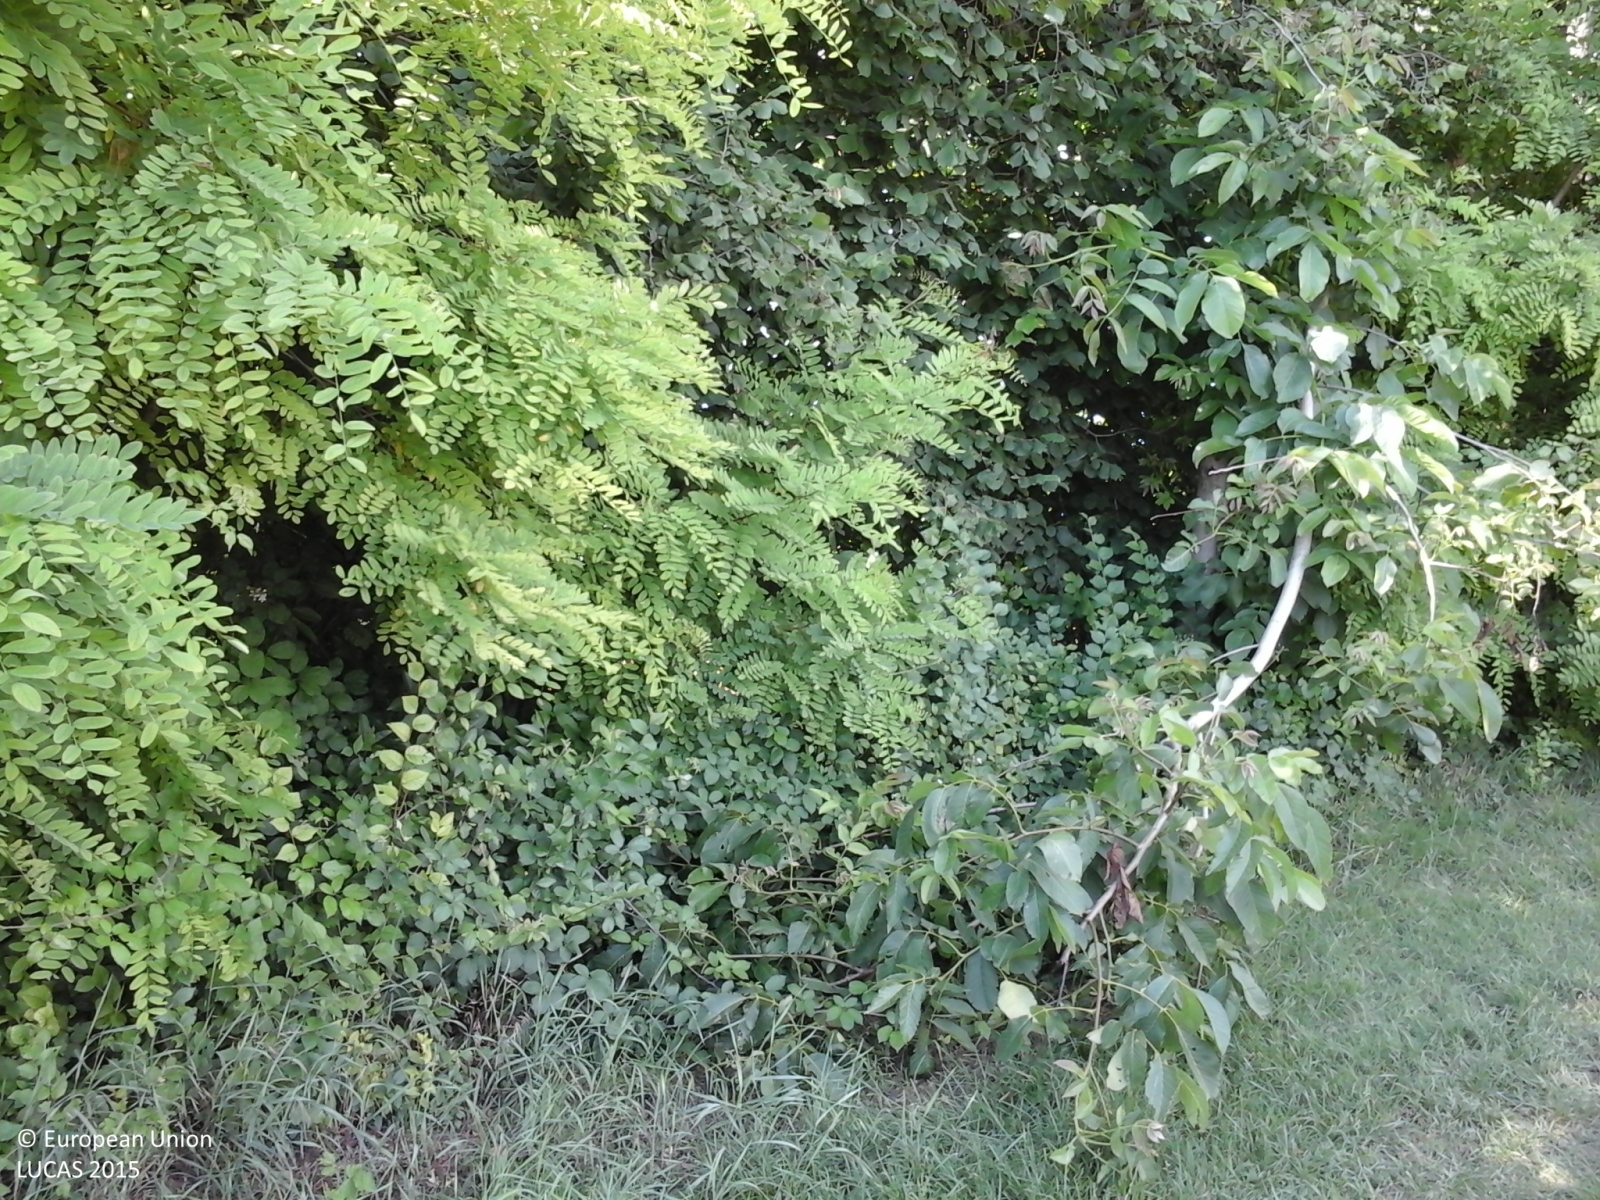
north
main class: Cropland
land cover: Common wheat
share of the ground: > 75 %
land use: Agriculture (excluding fallow land and kitchen gardens)
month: June
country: IT
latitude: 45.8910
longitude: 12.4324
